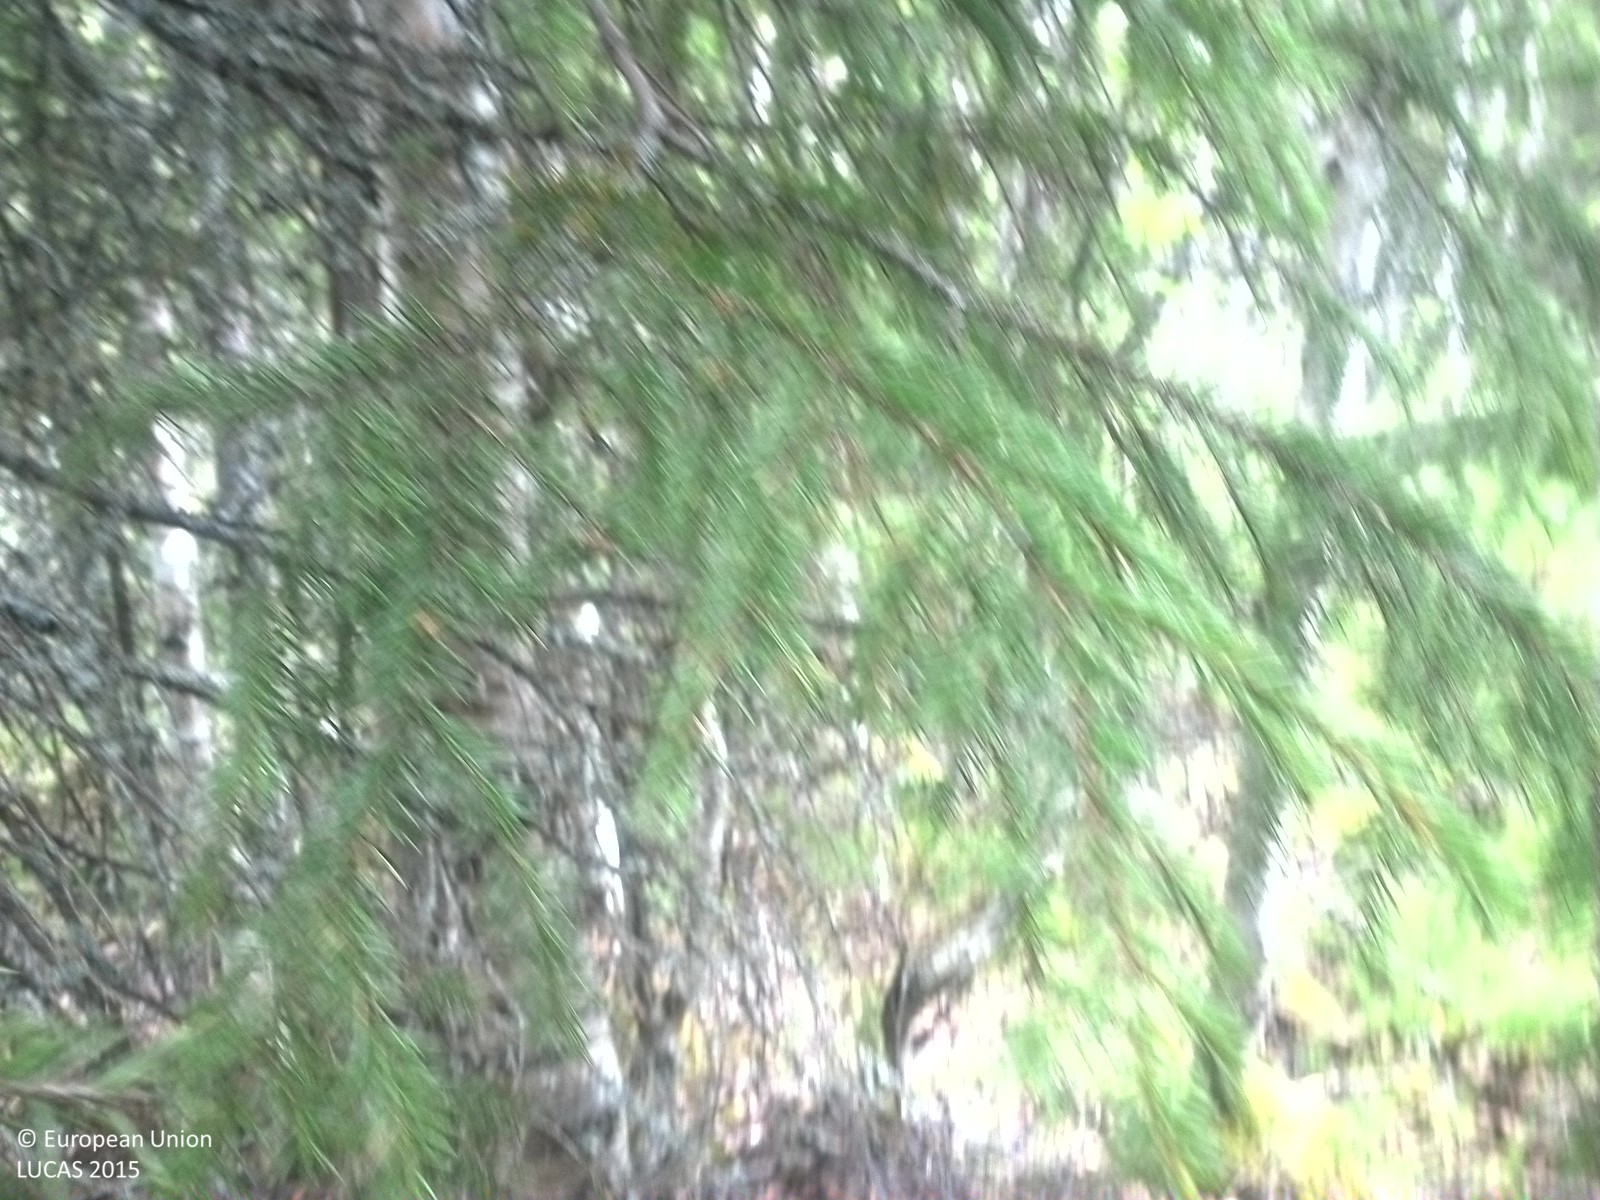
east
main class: Woodland
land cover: Spruce dominated mixed woodland
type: boreal forest
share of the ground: > 75 %
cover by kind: coniferous forest trees 60 %, broadleaved forest trees 25 %, shrubs 15 %
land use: Forestry
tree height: > 5 m
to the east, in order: Spruce dominated mixed woodland; Broadleaved woodland; Spruce dominated coniferous woodland; Inland marshes; Spruce dominated coniferous woodland; Peatbogs
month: June
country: SE
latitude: 63.4675
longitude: 15.0528
